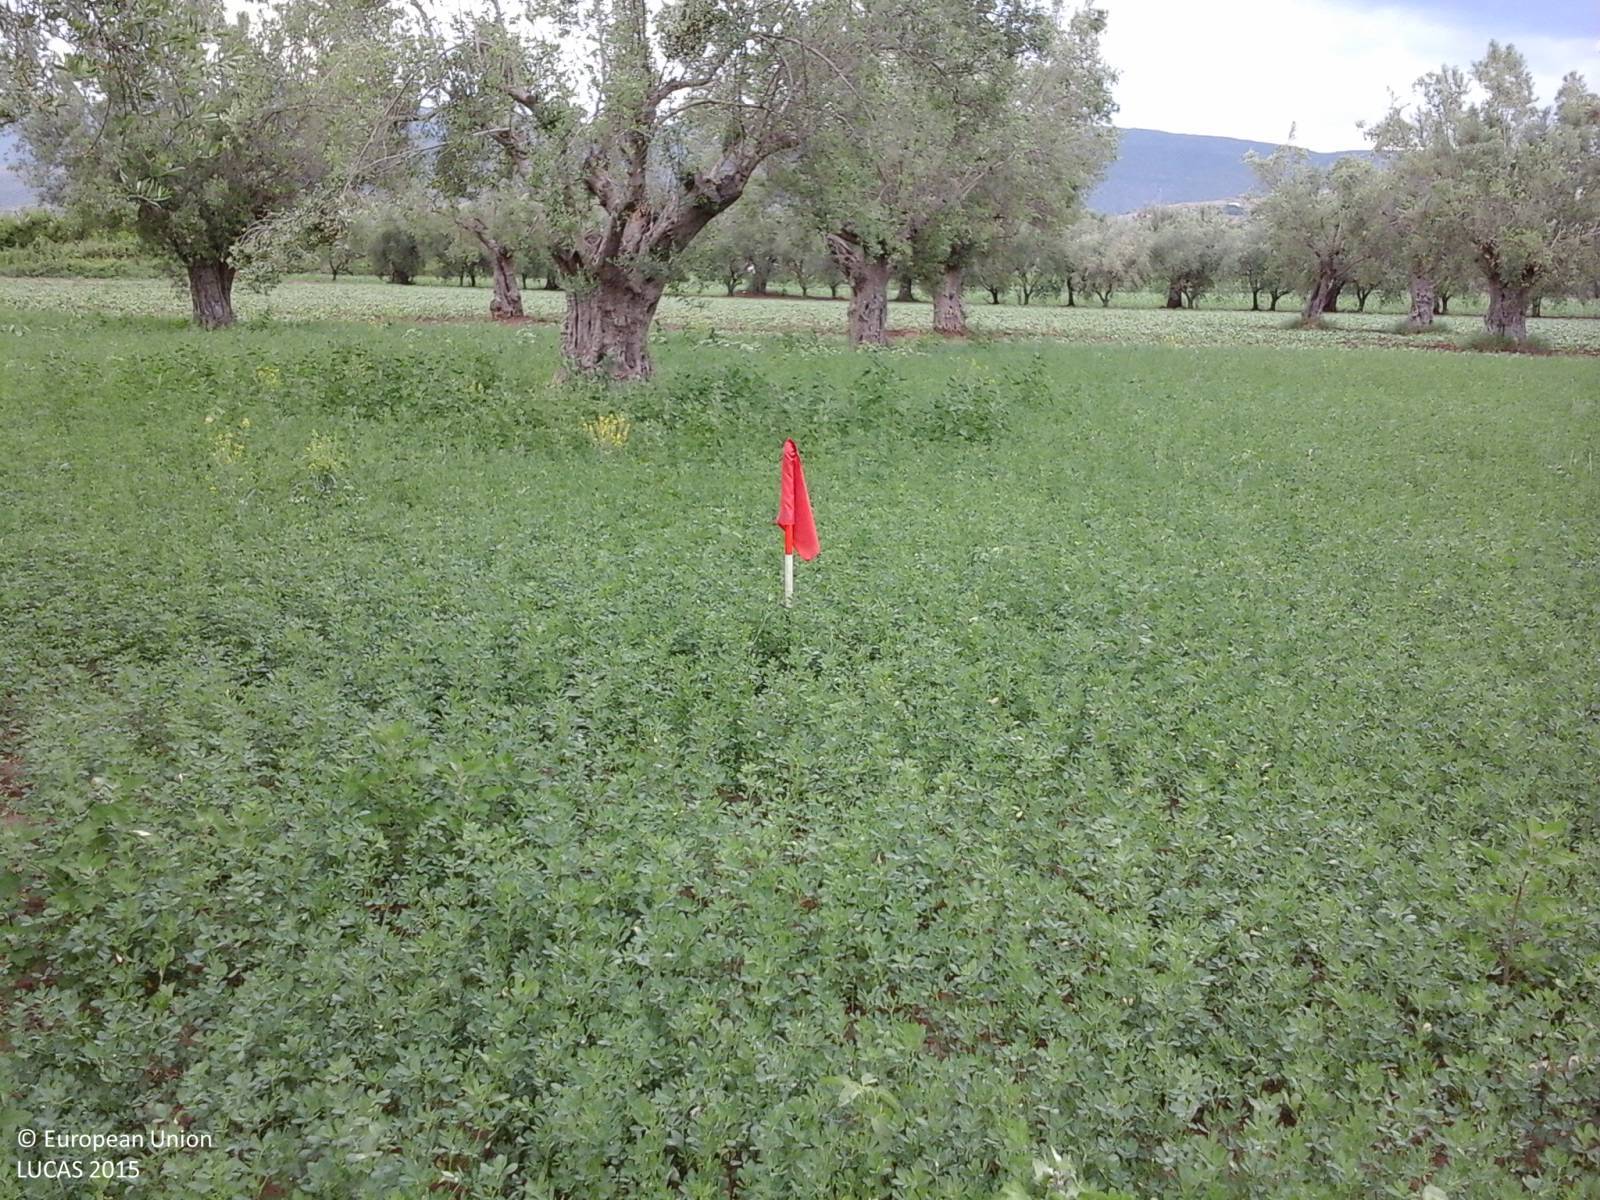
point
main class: Cropland
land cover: Lucerne
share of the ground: > 75 %
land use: Agriculture (excluding fallow land and kitchen gardens)
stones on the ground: < 10 %
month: May
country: IT
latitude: 41.1560
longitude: 14.1900
